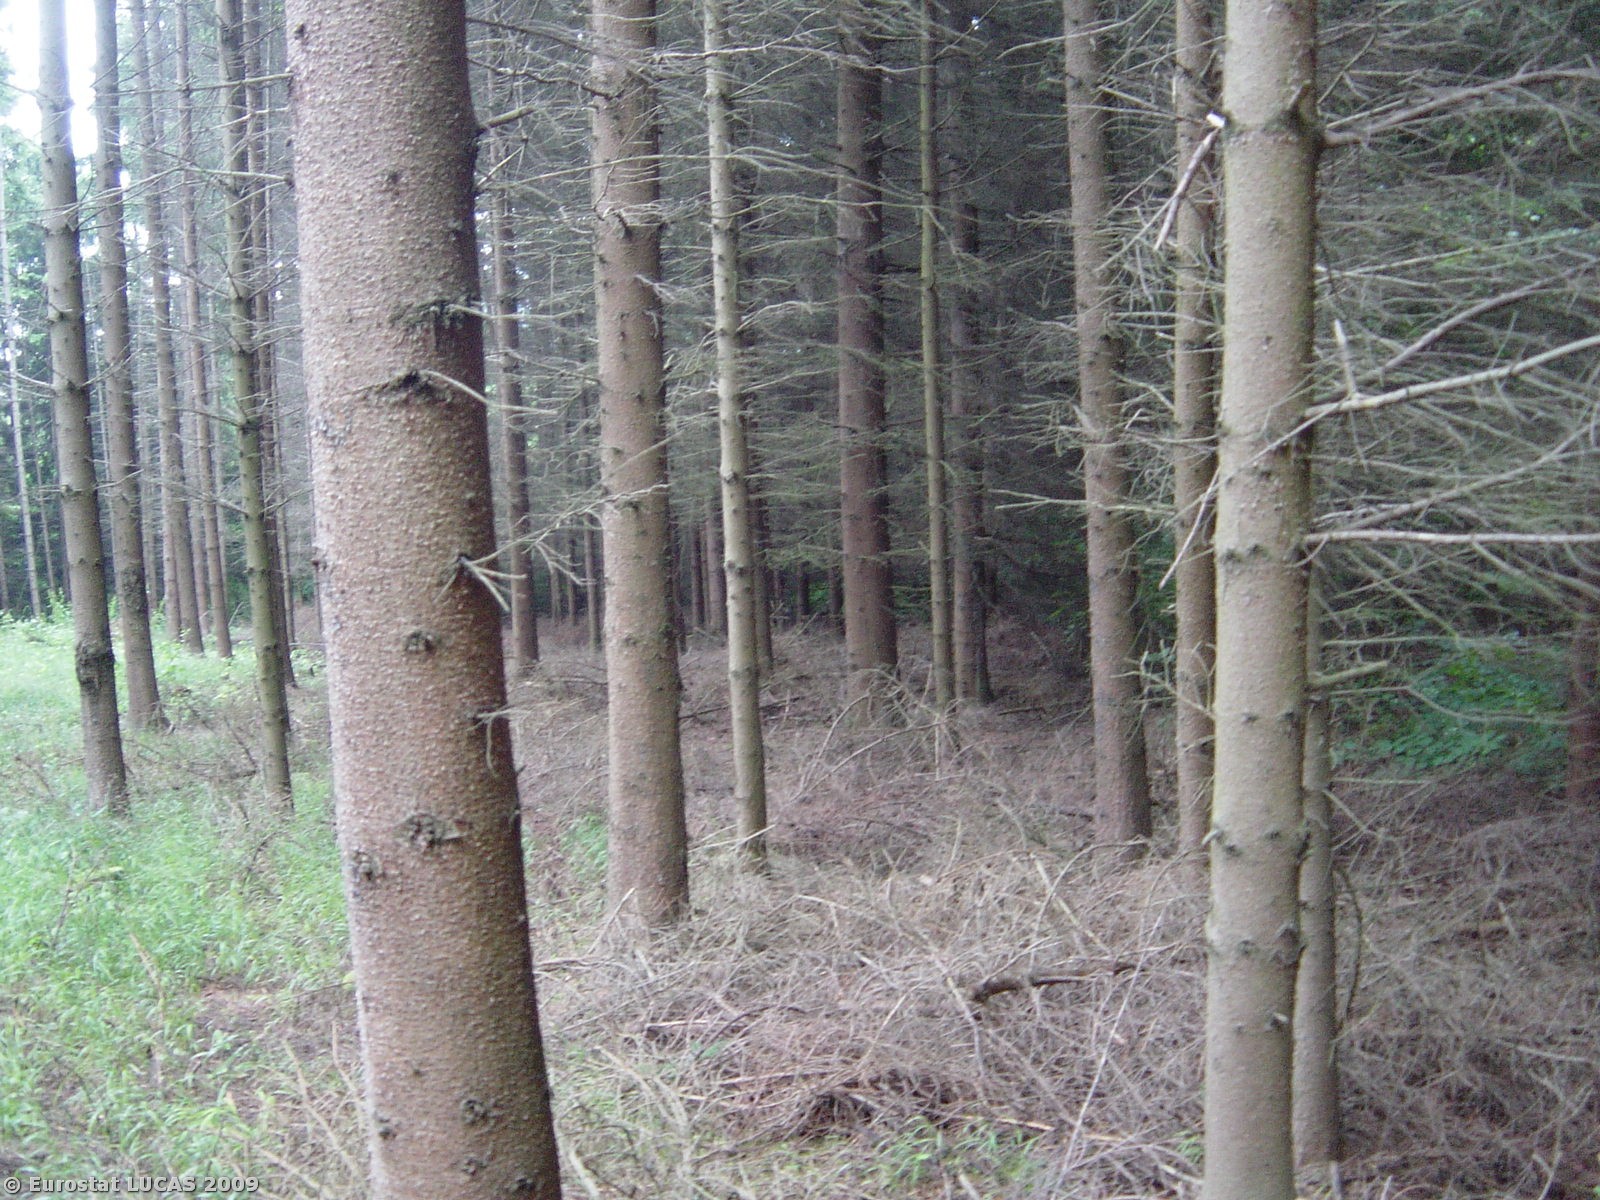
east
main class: Woodland
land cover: Coniferous woodland
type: hemiboreal forest and nemoral coniferous forest and mixed broadleaved-coniferous forest
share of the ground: > 75 %
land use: Forestry
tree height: > 5 m
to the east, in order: Coniferous woodland; Tracks; Coniferous woodland; Broadleaved woodland; Tracks; Temporary grasslands; Tracks; Temporary grasslands; Broadleaved woodland; Rivers and streams
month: June
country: CZ
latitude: 49.2382
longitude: 17.1381
